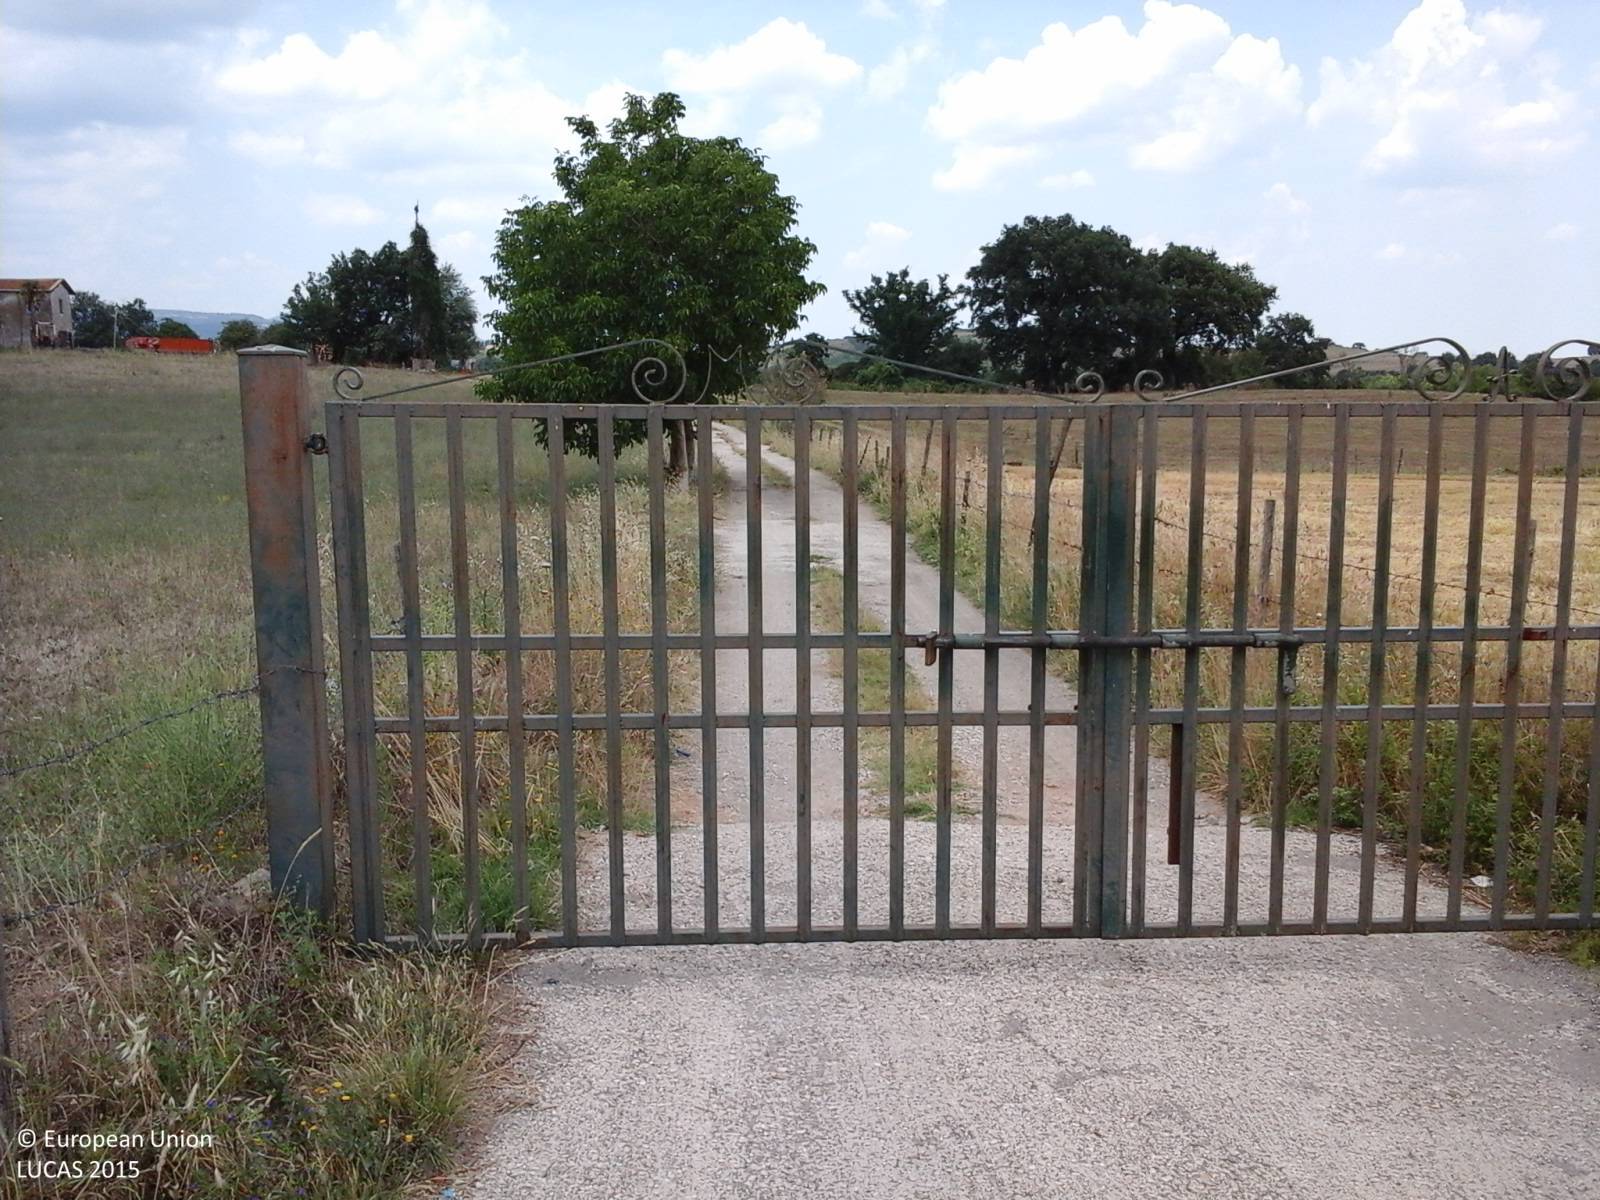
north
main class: Cropland
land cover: Temporary grasslands
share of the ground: > 75 %
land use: Agriculture (excluding fallow land and kitchen gardens)
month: June
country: IT
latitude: 42.2313
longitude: 12.2579
